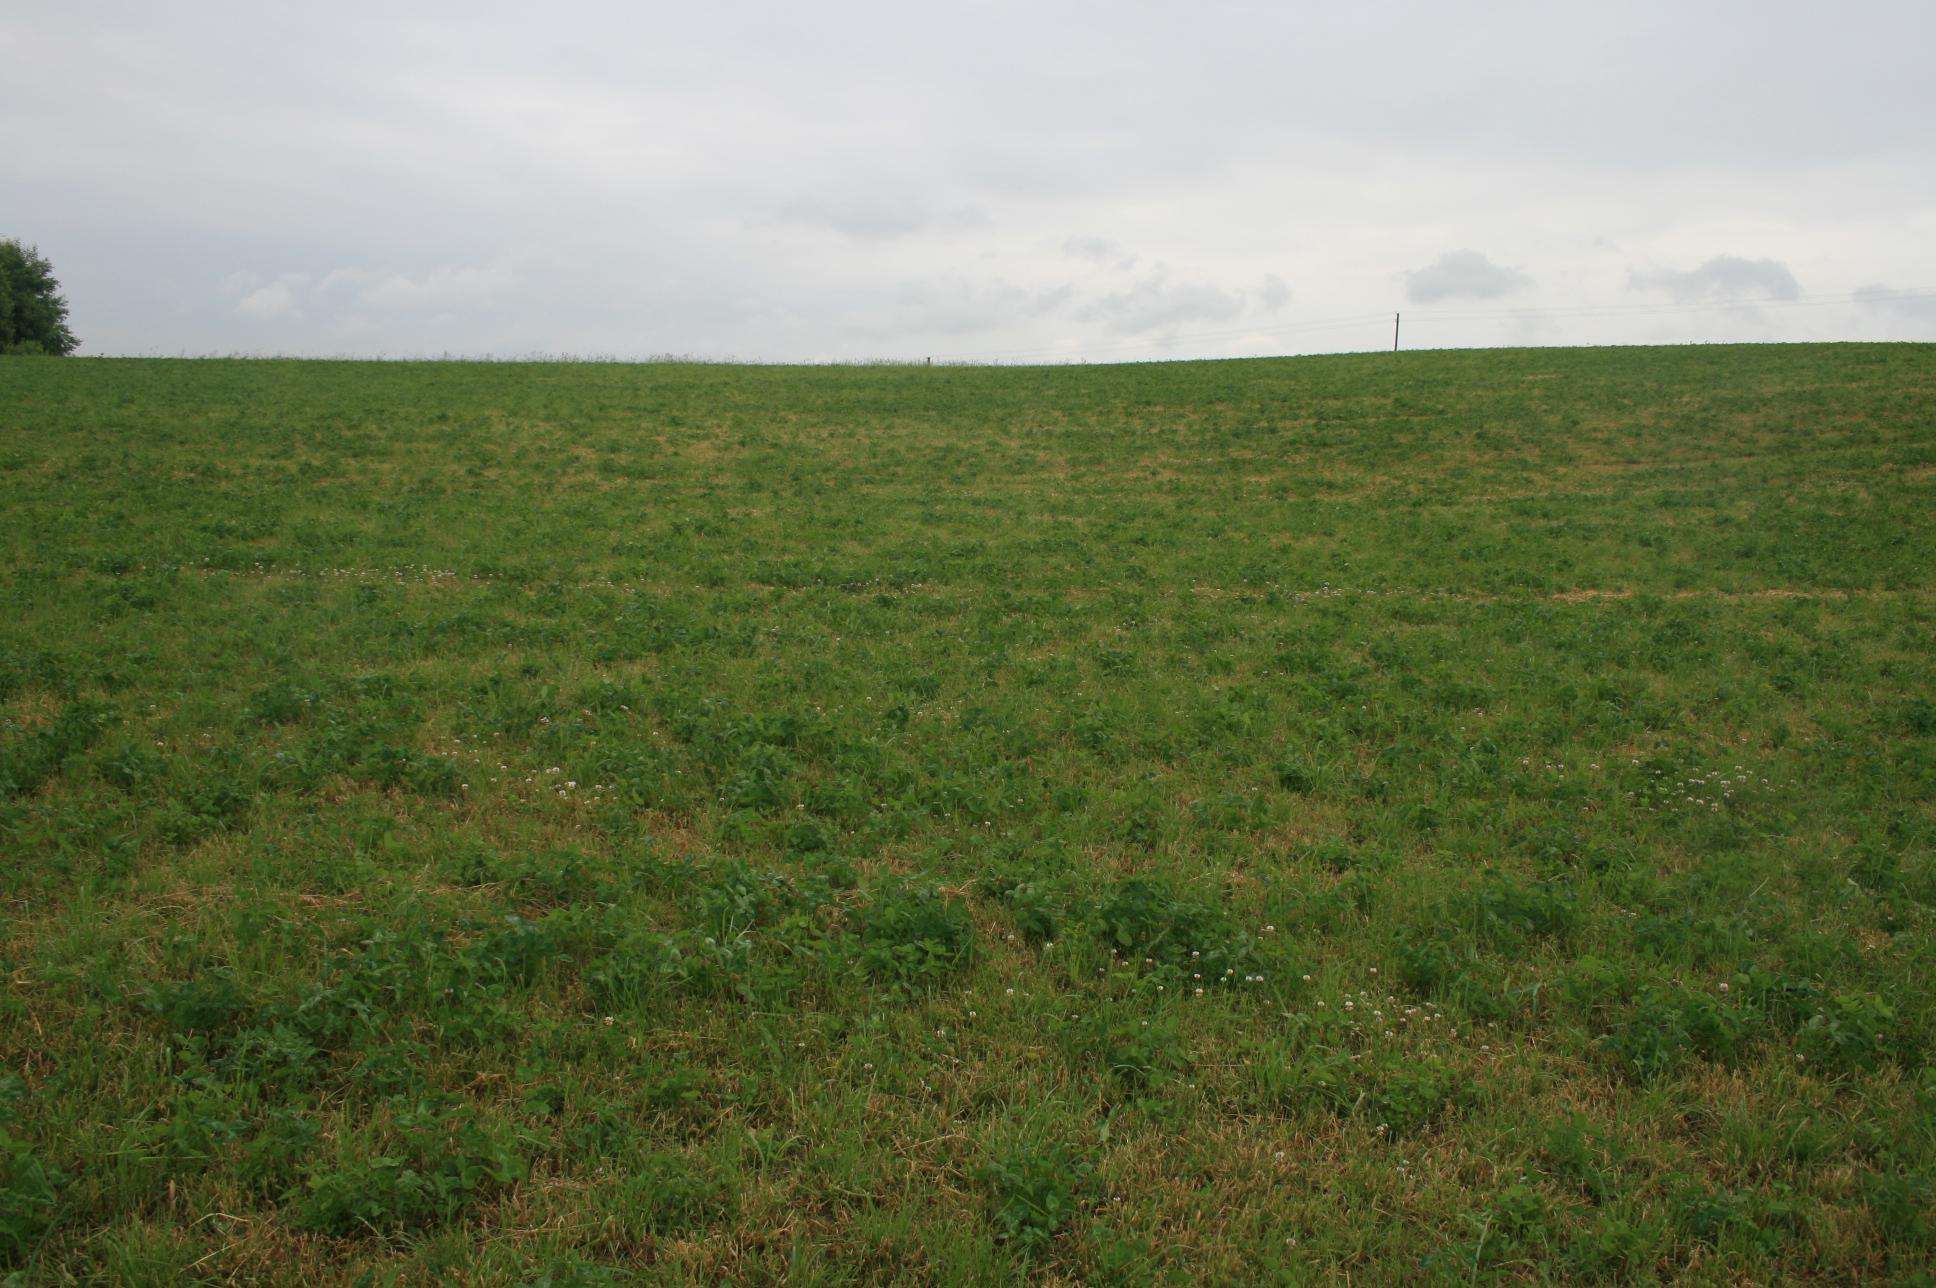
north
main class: Grassland
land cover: Grassland without tree/shrub cover
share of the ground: > 75 %
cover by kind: herbaceous plants 100 %
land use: Agriculture (excluding fallow land and kitchen gardens)
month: June
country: LT
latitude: 55.5172
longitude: 22.3324
